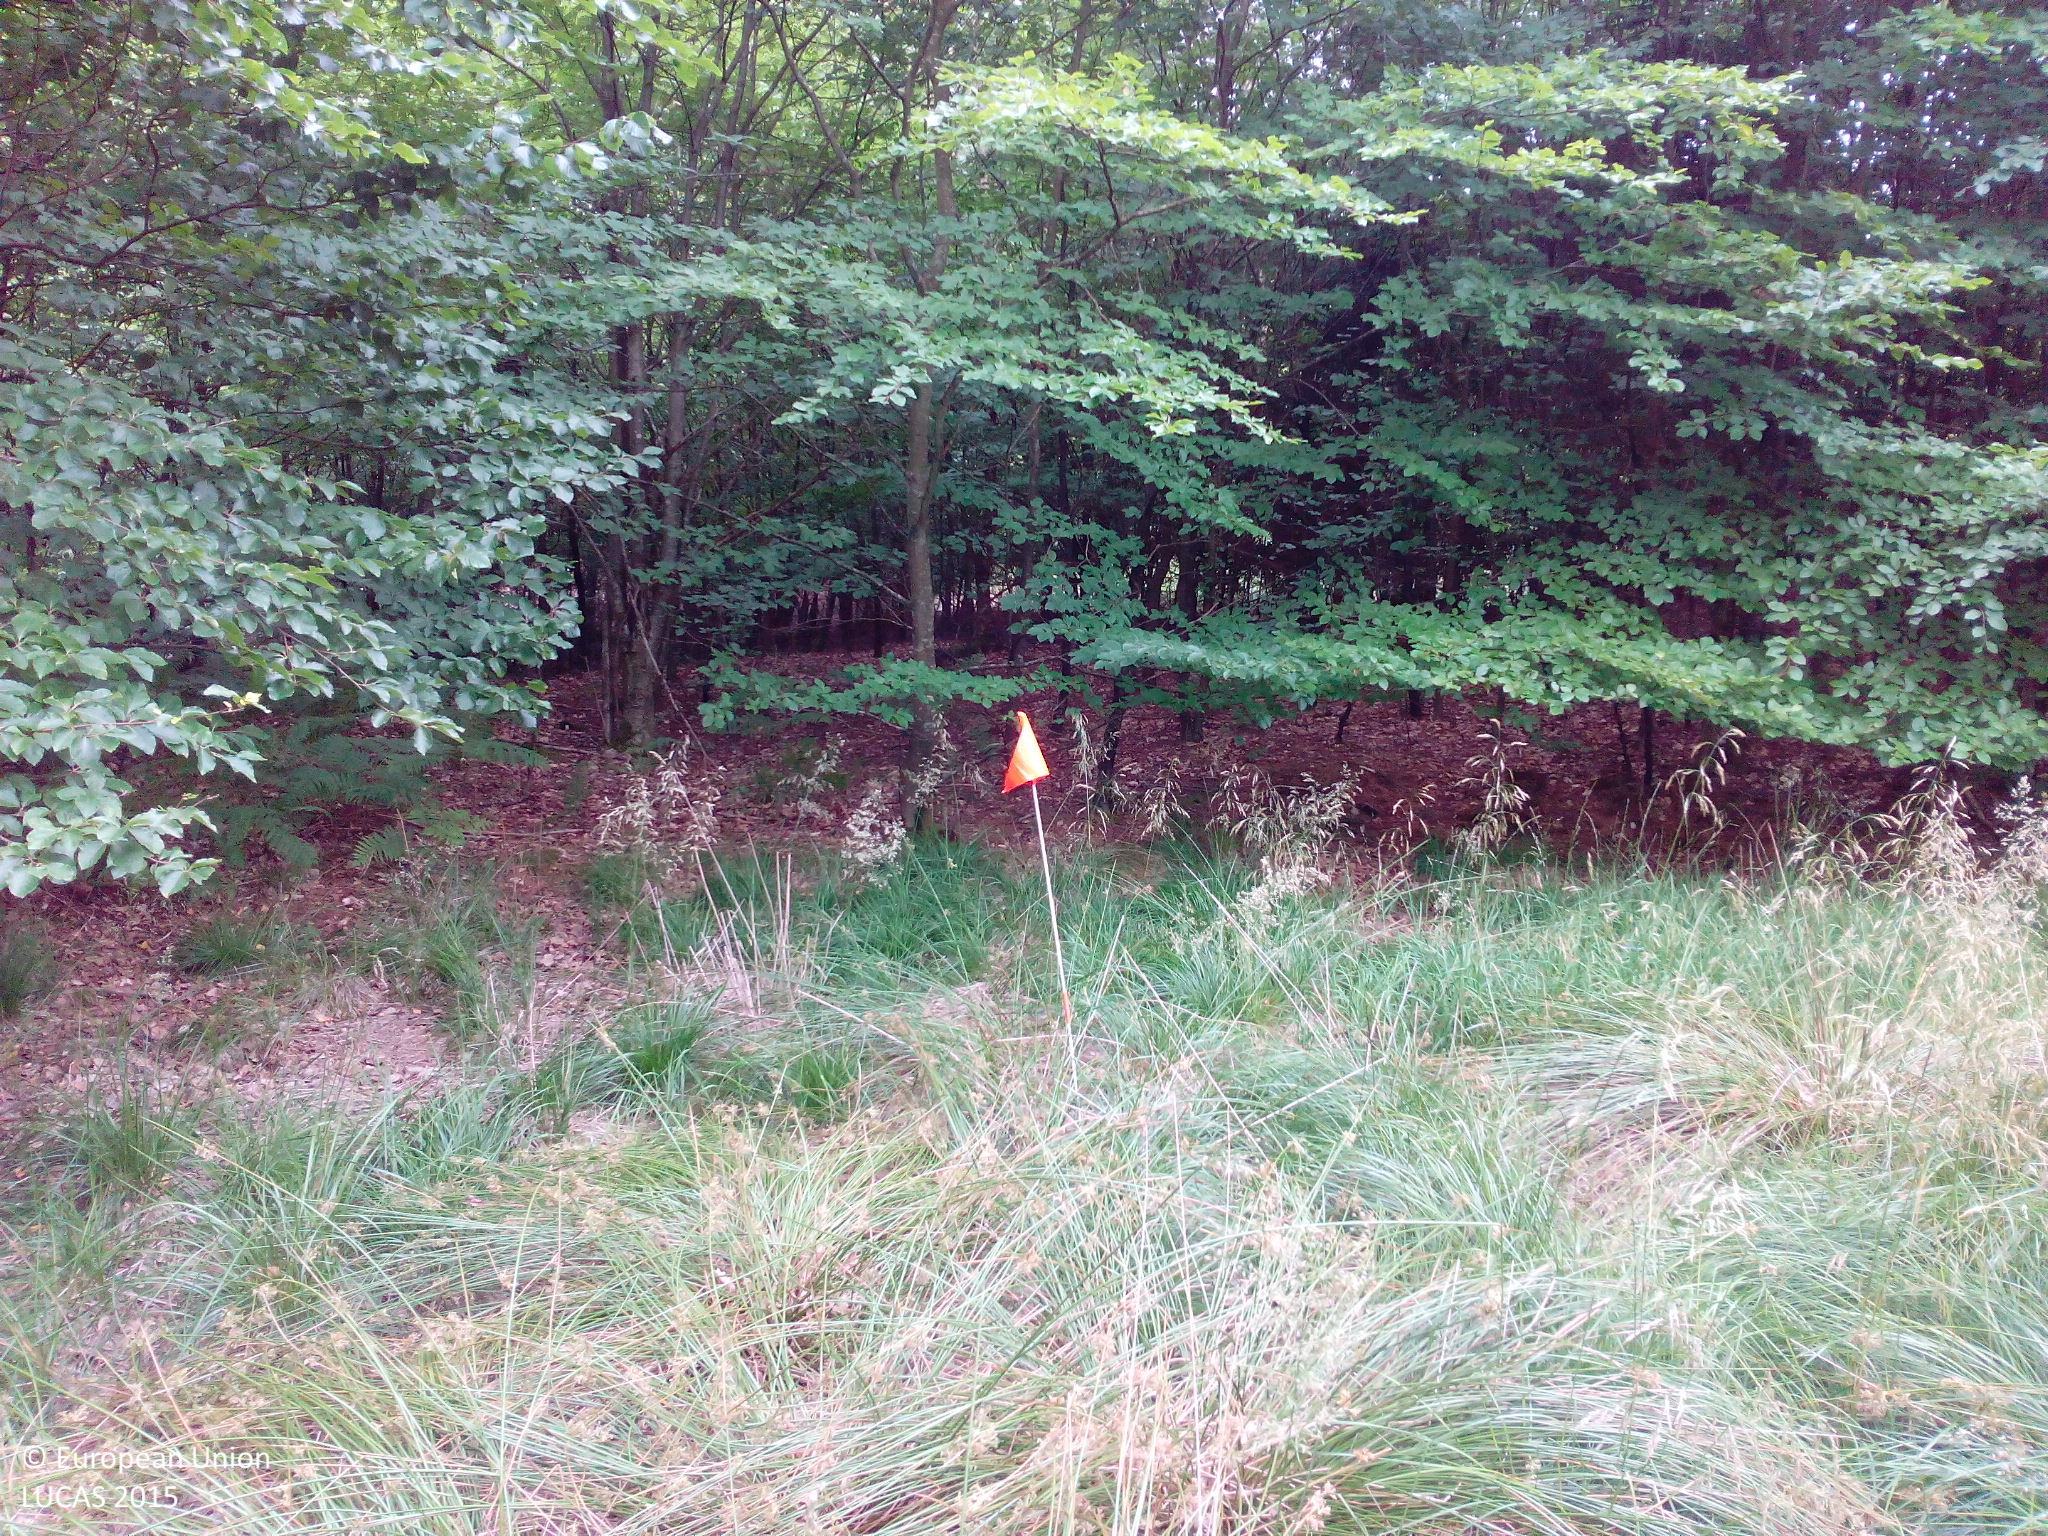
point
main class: Woodland
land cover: Broadleaved woodland
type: beech forest
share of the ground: > 75 %
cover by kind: broadleaved forest trees 80 %, herbaceous plants 20 %
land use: Forestry
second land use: Amenities, museums, leisure
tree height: > 5 m
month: July
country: DK
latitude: 56.0043
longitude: 12.3552
